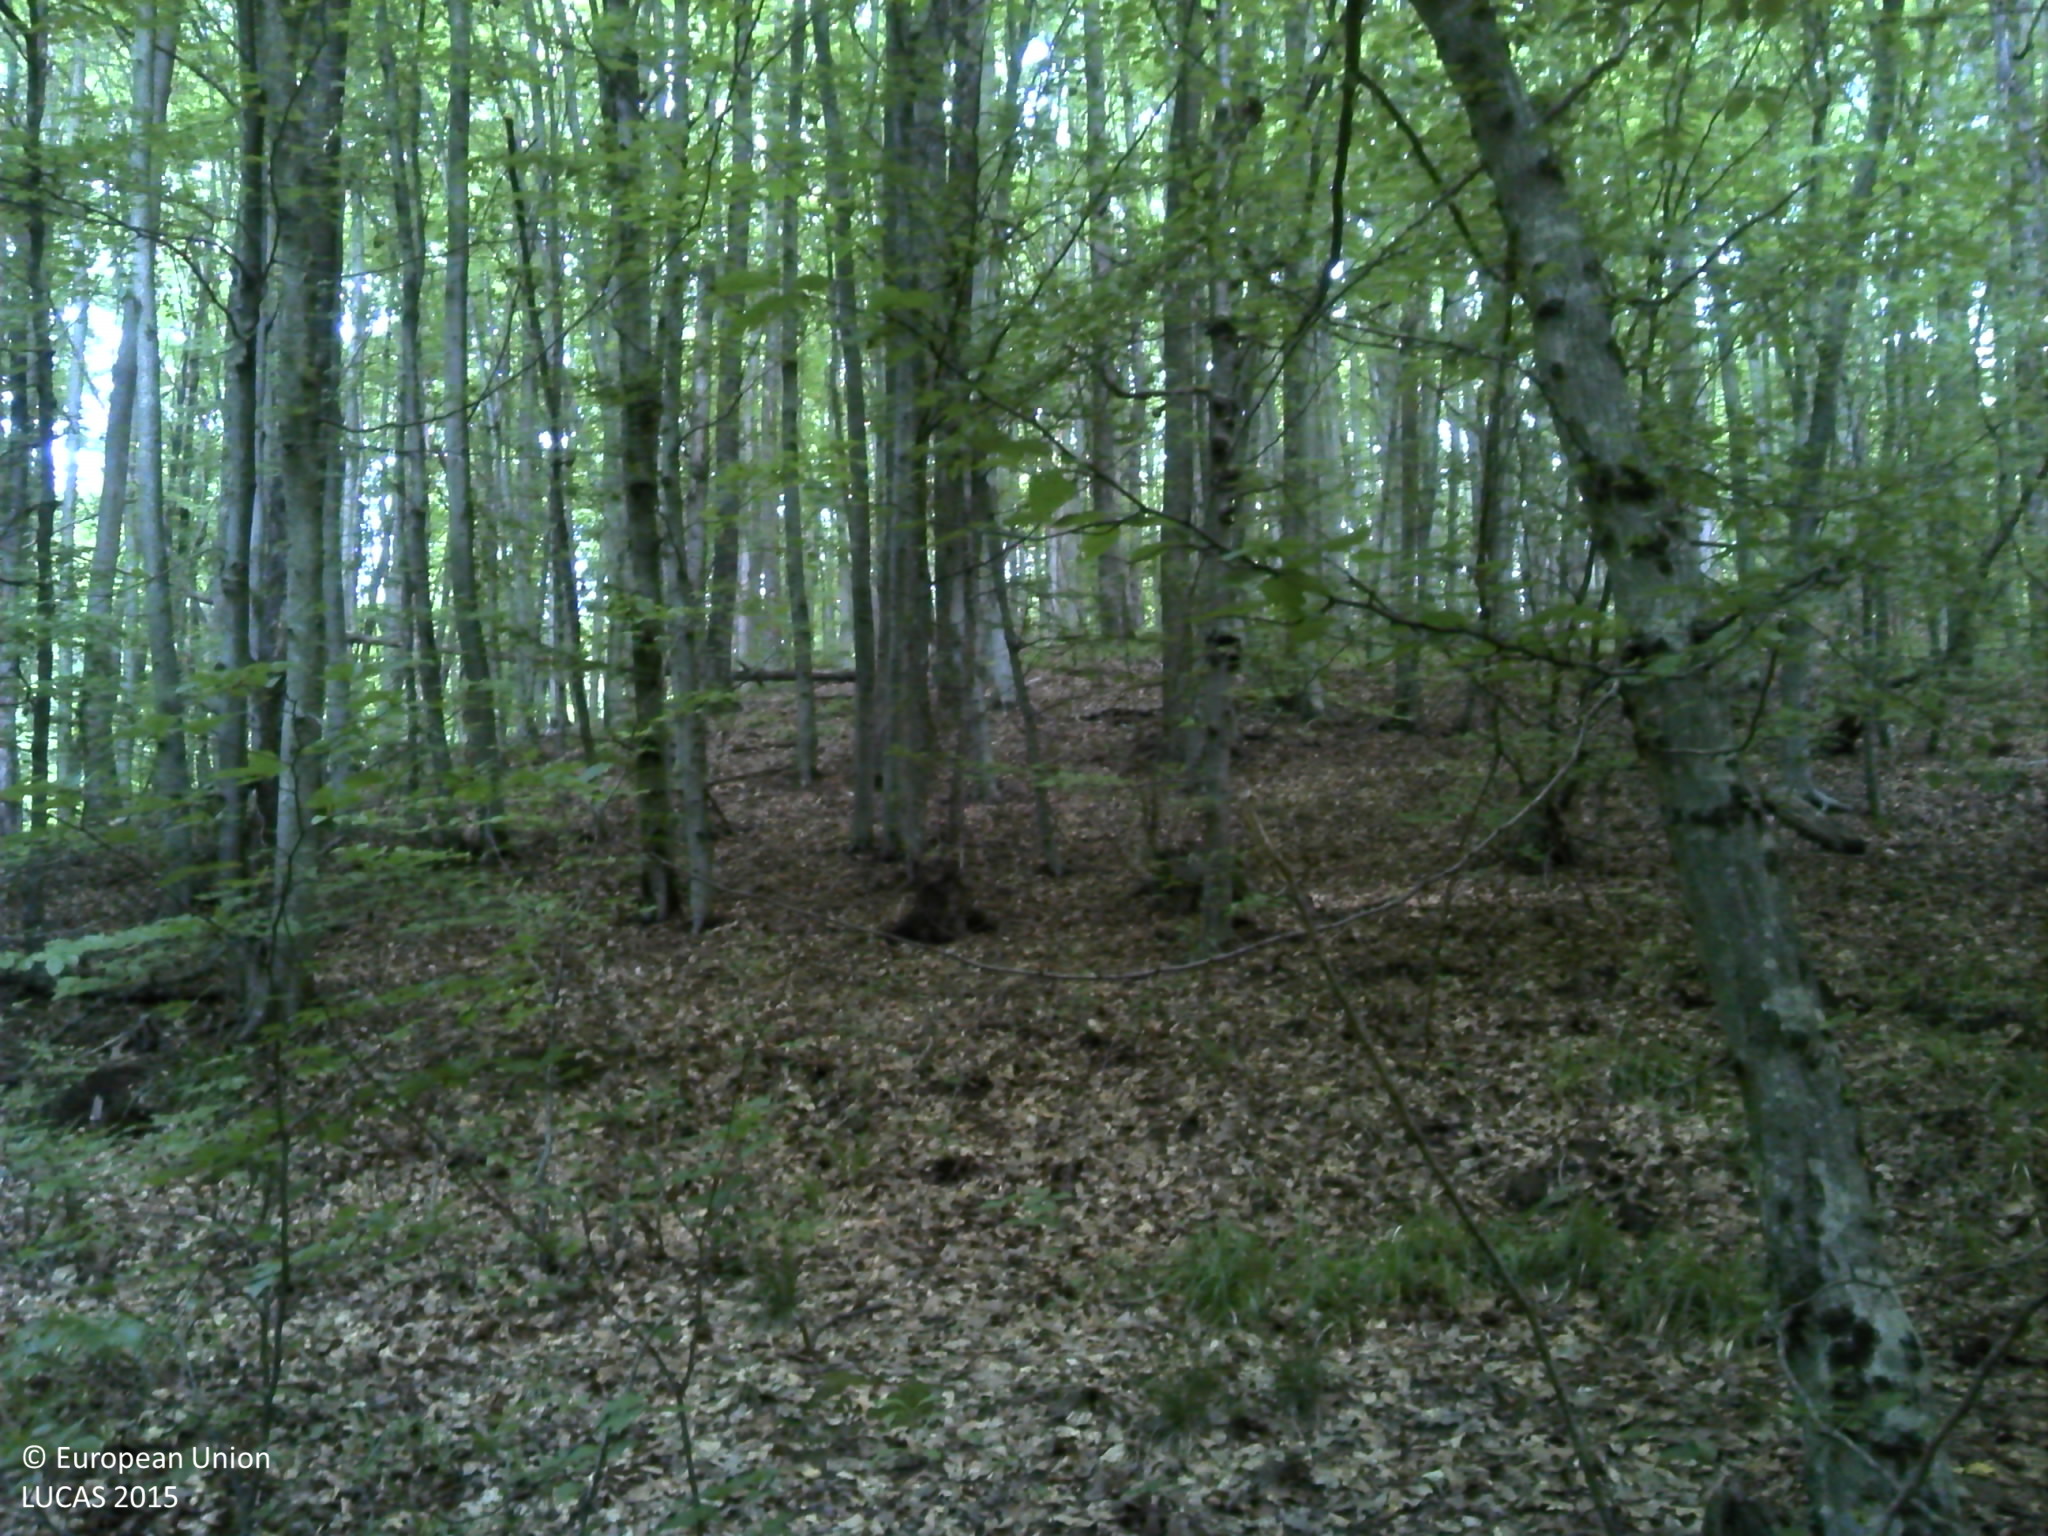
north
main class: Woodland
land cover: Broadleaved woodland
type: beech forest
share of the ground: > 75 %
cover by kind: broadleaved forest trees 80 %, lichens and mosses 20 %
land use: Forestry
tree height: > 5 m
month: June
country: HR
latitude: 45.4001
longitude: 17.2436
